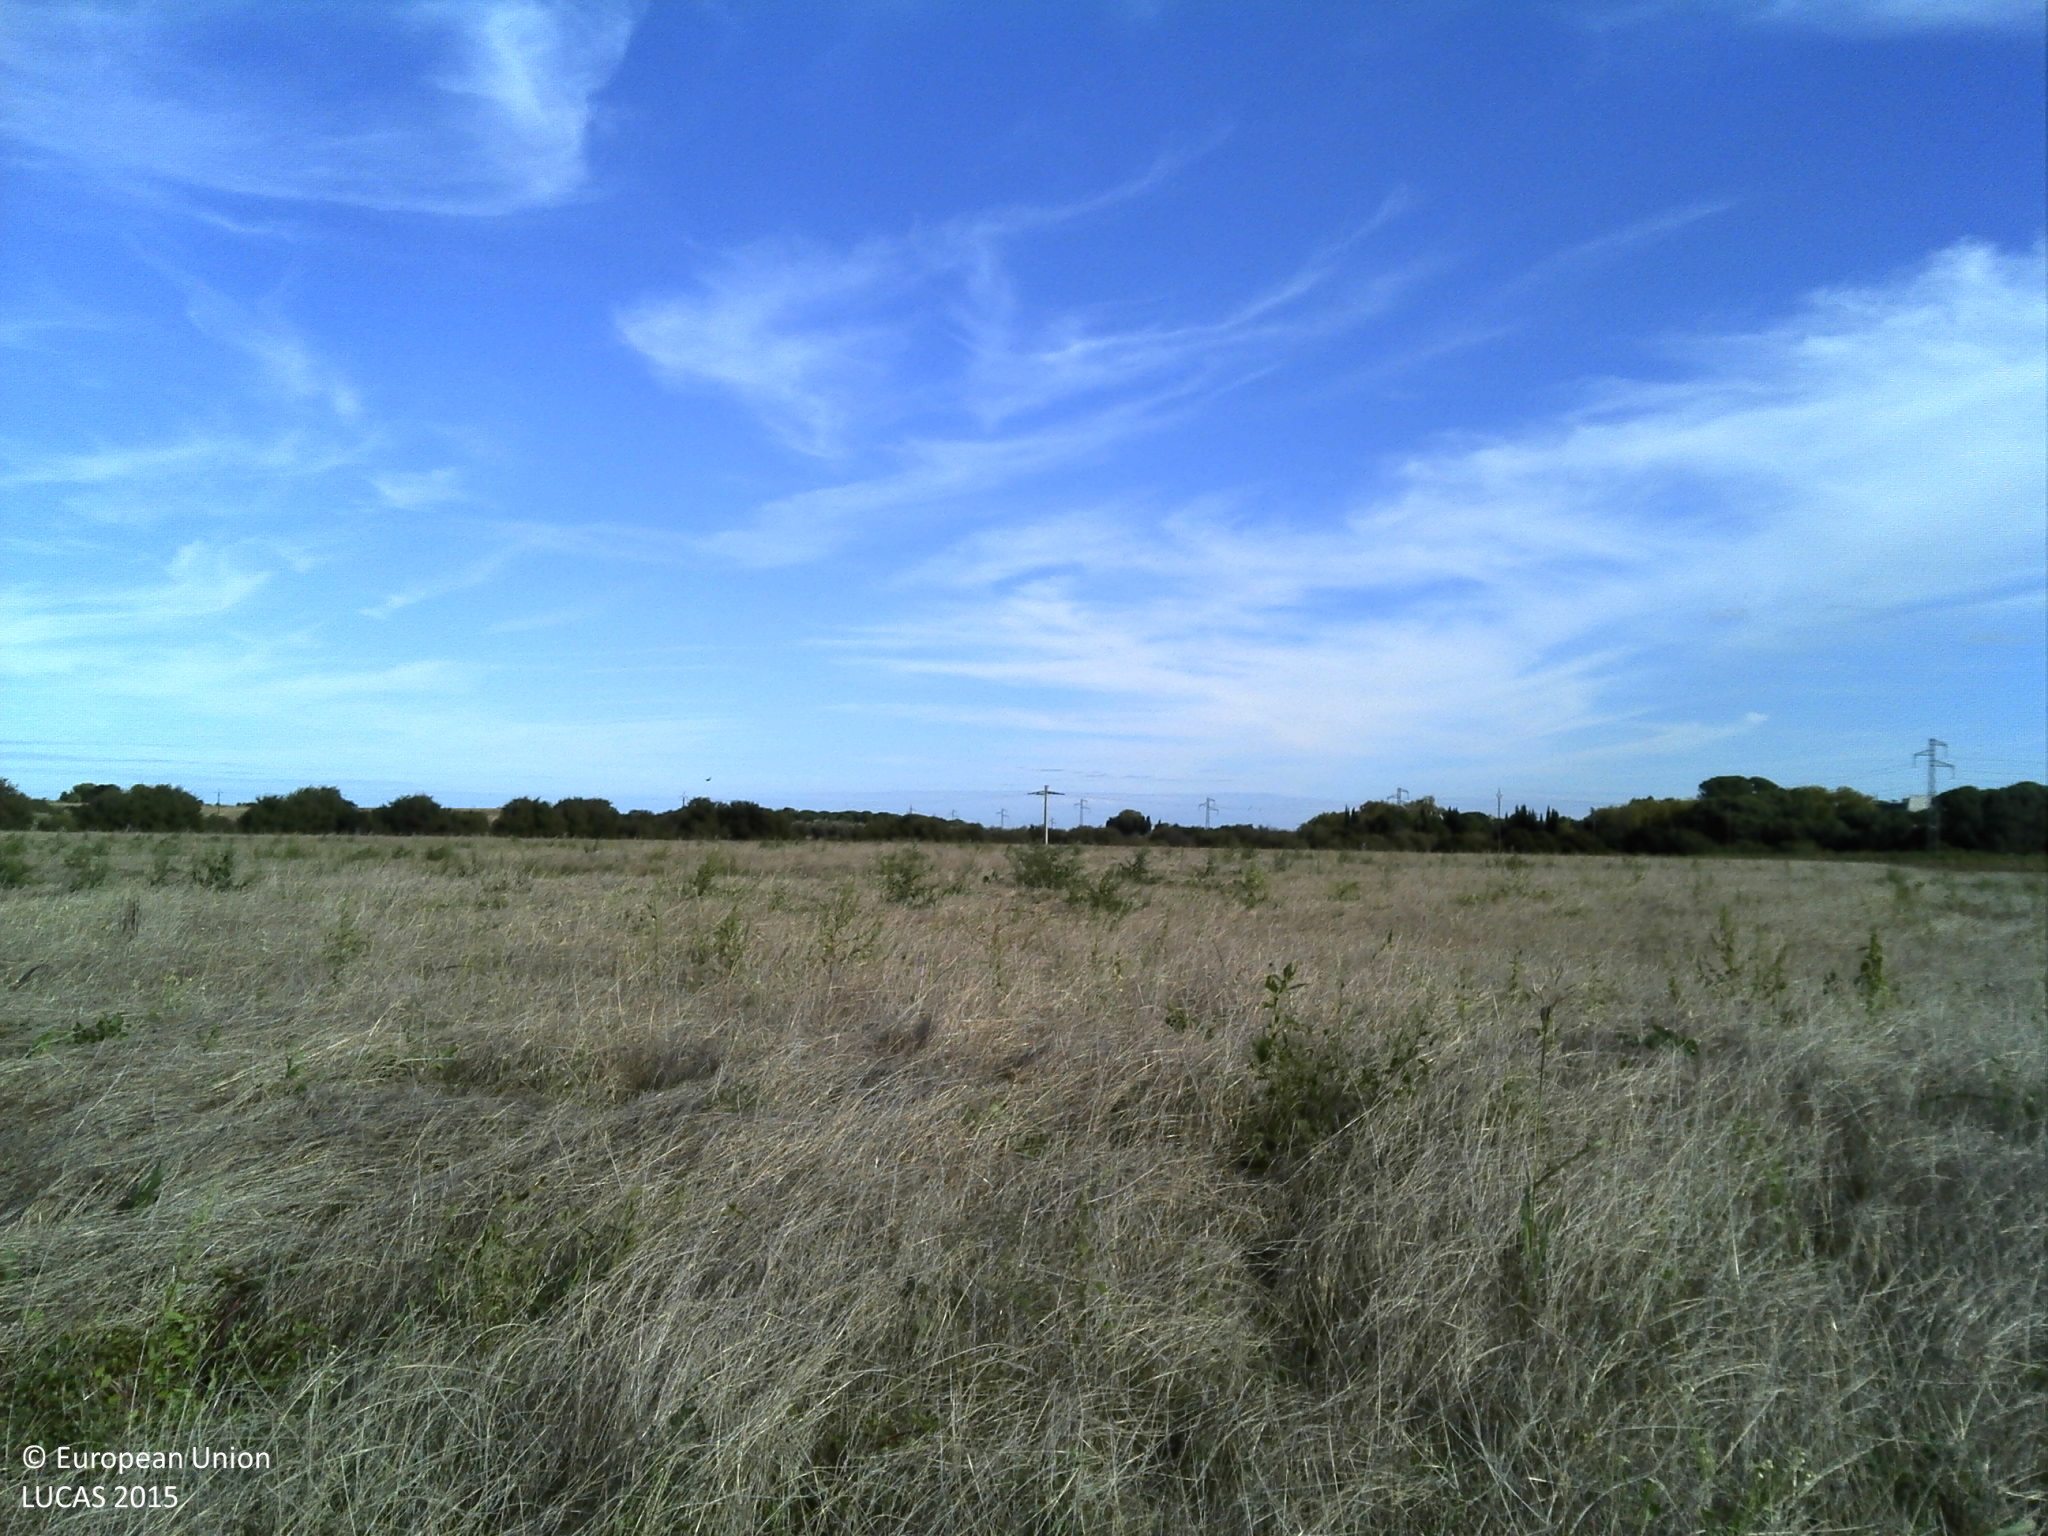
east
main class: Grassland
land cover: Spontaneously vegetated surfaces
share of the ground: > 75 %
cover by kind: herbaceous plants 95 %, unconsolidated bare surface 5 %
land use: Fallow land
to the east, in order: Spontaneously vegetated surfaces; Tracks; Broadleaved woodland
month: October
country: FR
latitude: 43.3431
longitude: 3.3855
